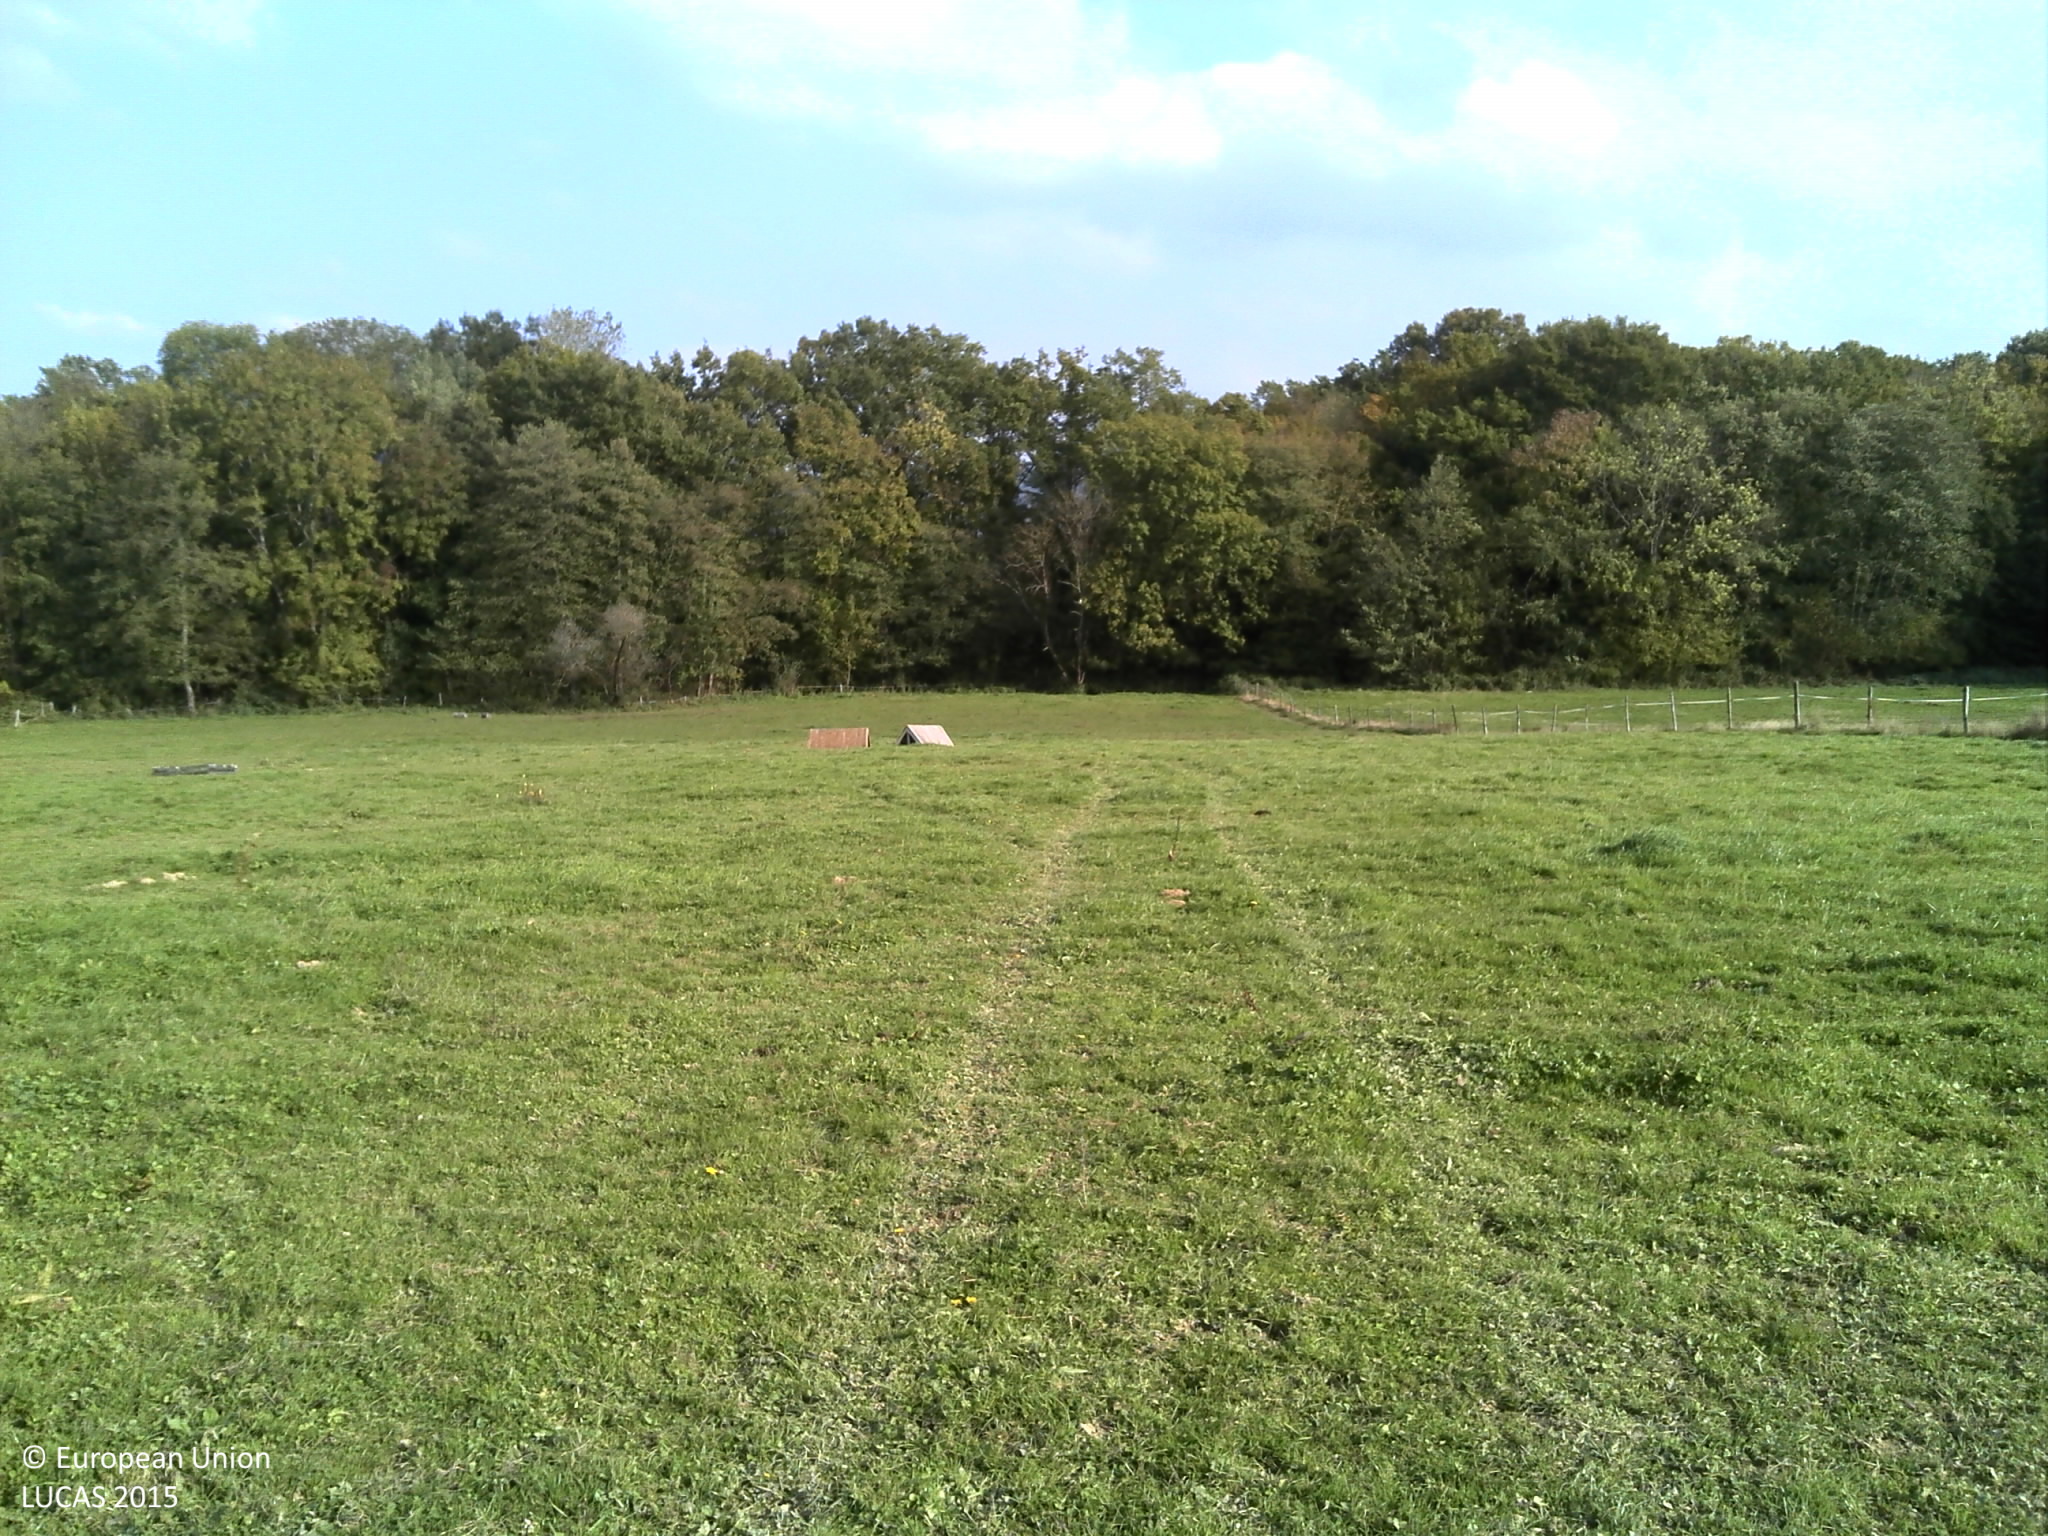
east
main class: Grassland
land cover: Grassland without tree/shrub cover
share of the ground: > 75 %
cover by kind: herbaceous plants 100 %
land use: Agriculture (excluding fallow land and kitchen gardens)
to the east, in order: Grassland without tree/shrub cover; Fences; Rivers and streams; Broadleaved woodland; Fences; Grassland without tree/shrub cover
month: October
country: FR
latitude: 46.2668
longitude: 5.3190
